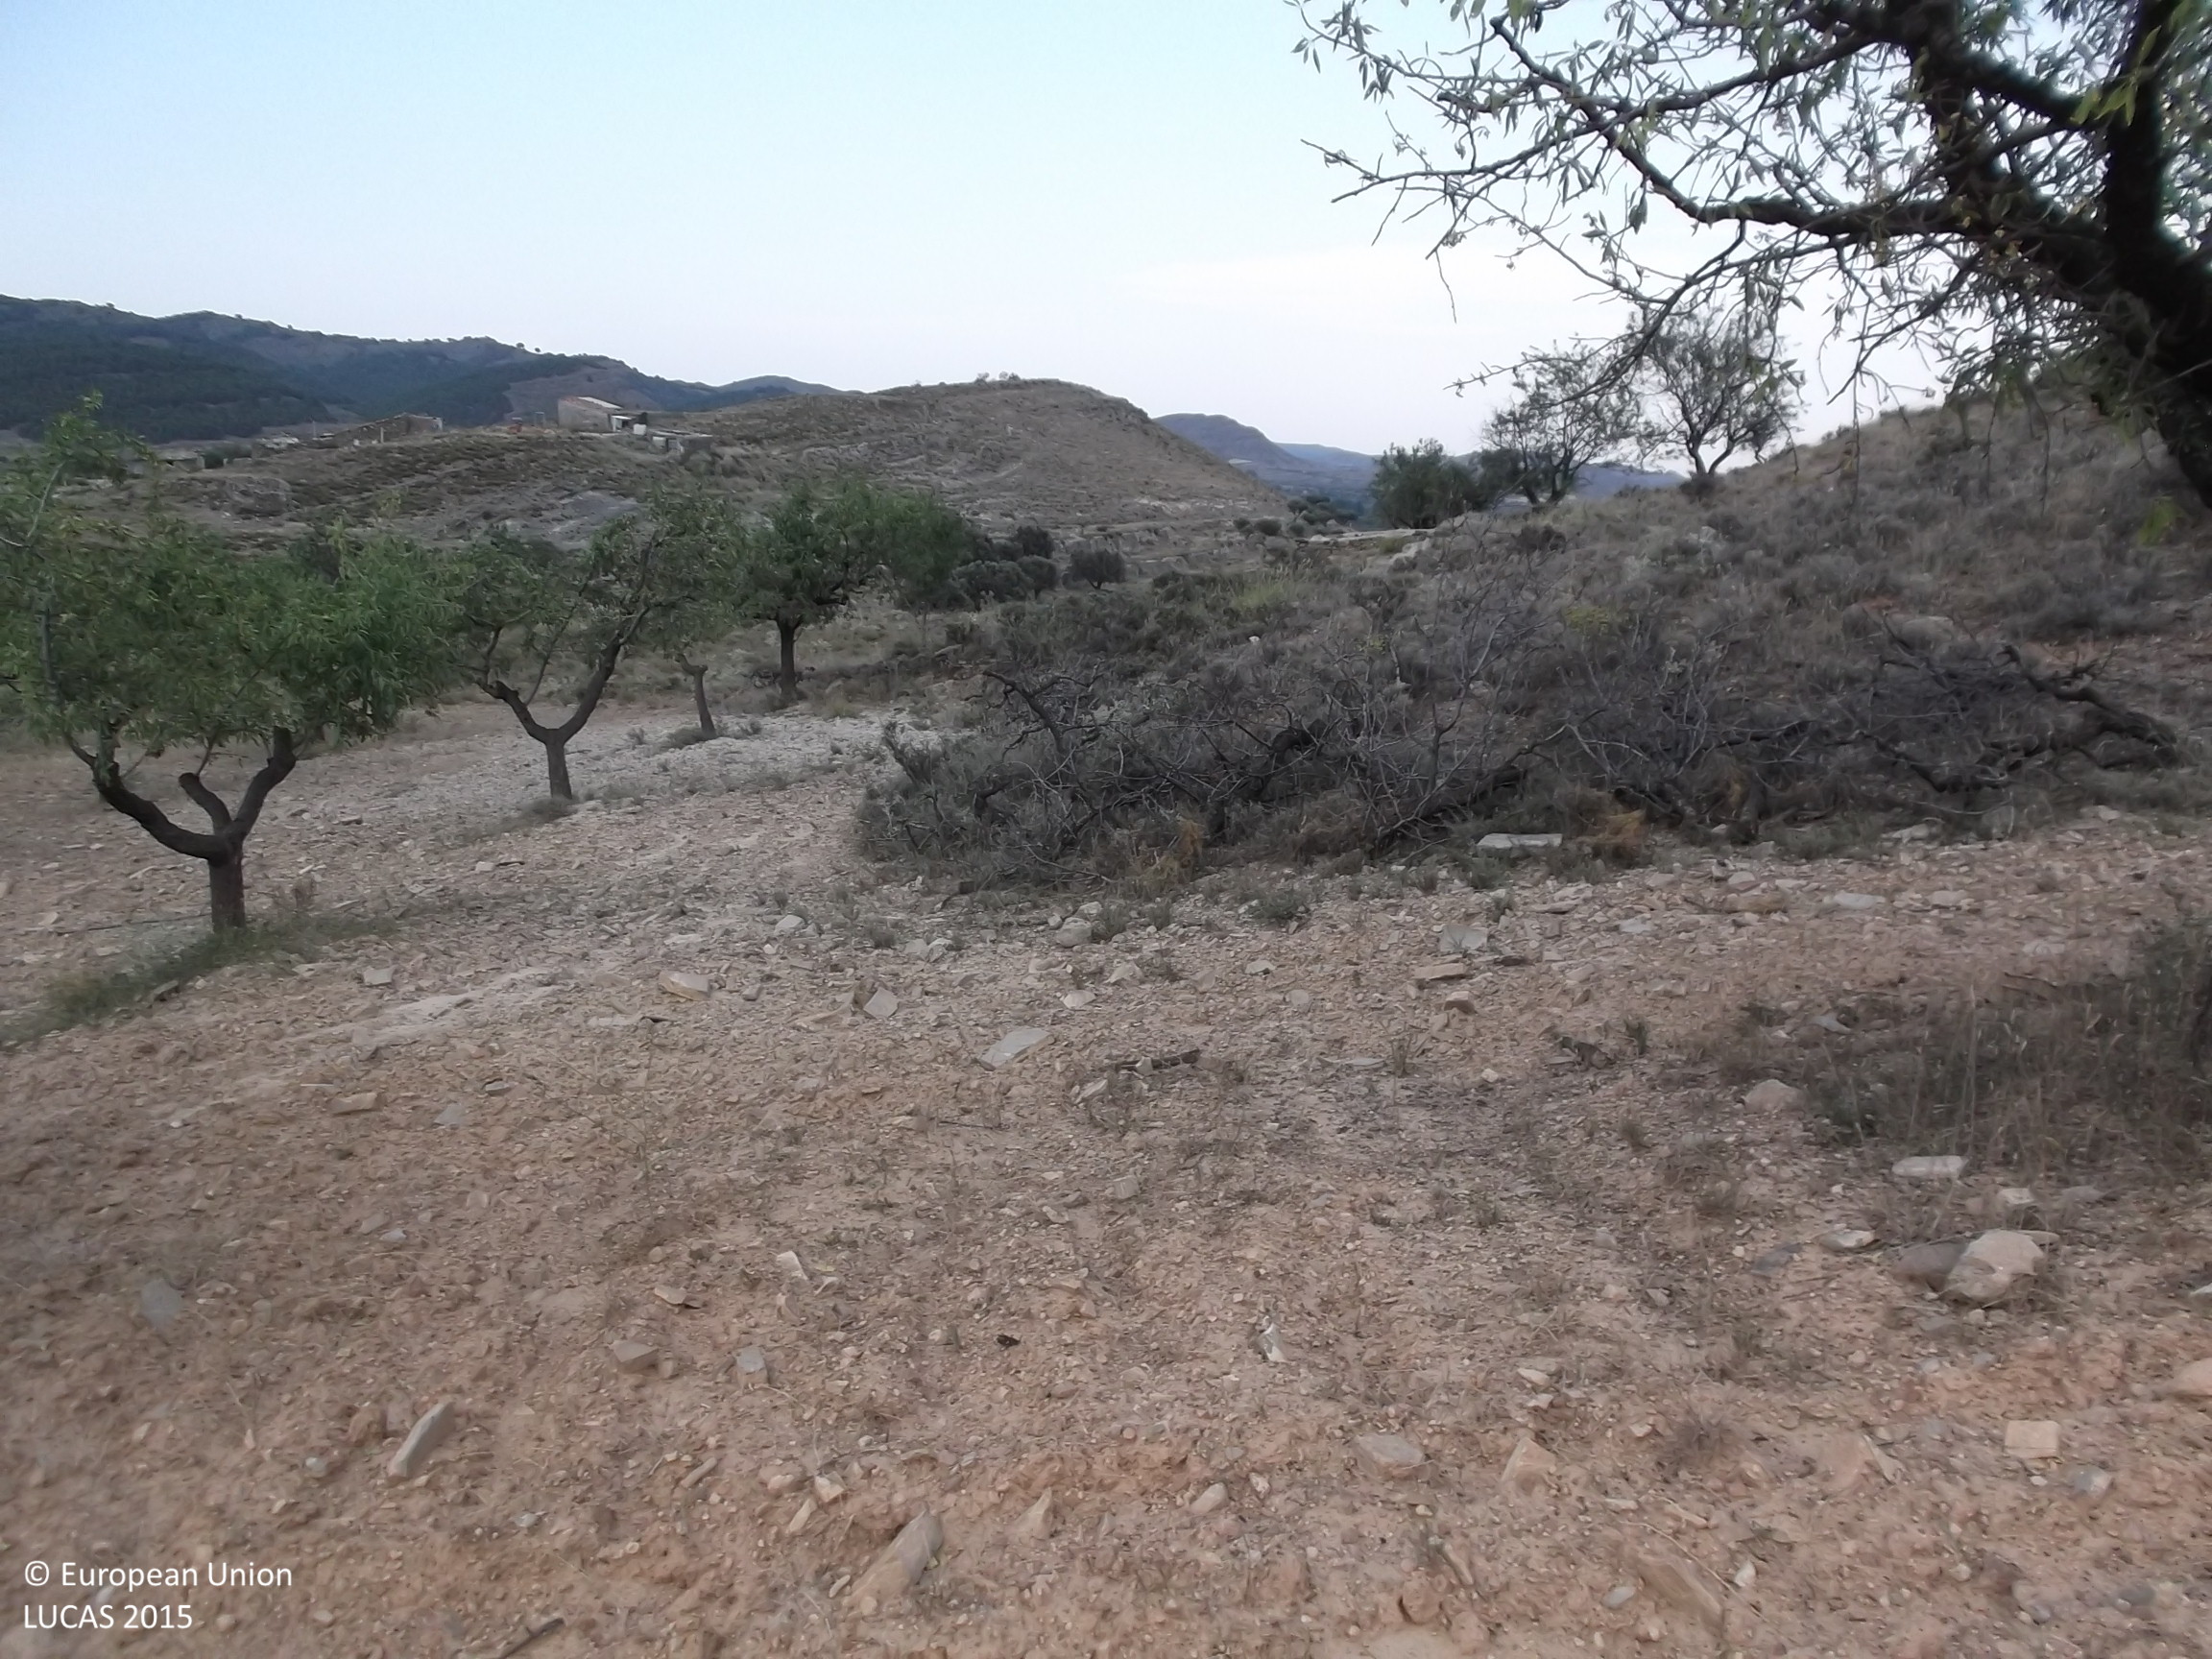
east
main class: Cropland
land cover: Nuts trees
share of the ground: 25 - 50 %
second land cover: Other bare soil
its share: > 75 %
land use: Agriculture (excluding fallow land and kitchen gardens)
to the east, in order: Nuts trees; Other bare soil; Grassland without tree/shrub cover; Groves; Shrubland without tree cover; Groves; Dry stone walls; Shrubland without tree cover; Olive groves; Dry stone walls; Ditches and canals; Tracks; Dry stone walls; Olive groves; Dry stone walls; Nuts trees; Dry stone walls; Shrubland without tree cover
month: July
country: ES
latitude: 42.0641
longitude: -2.0121
